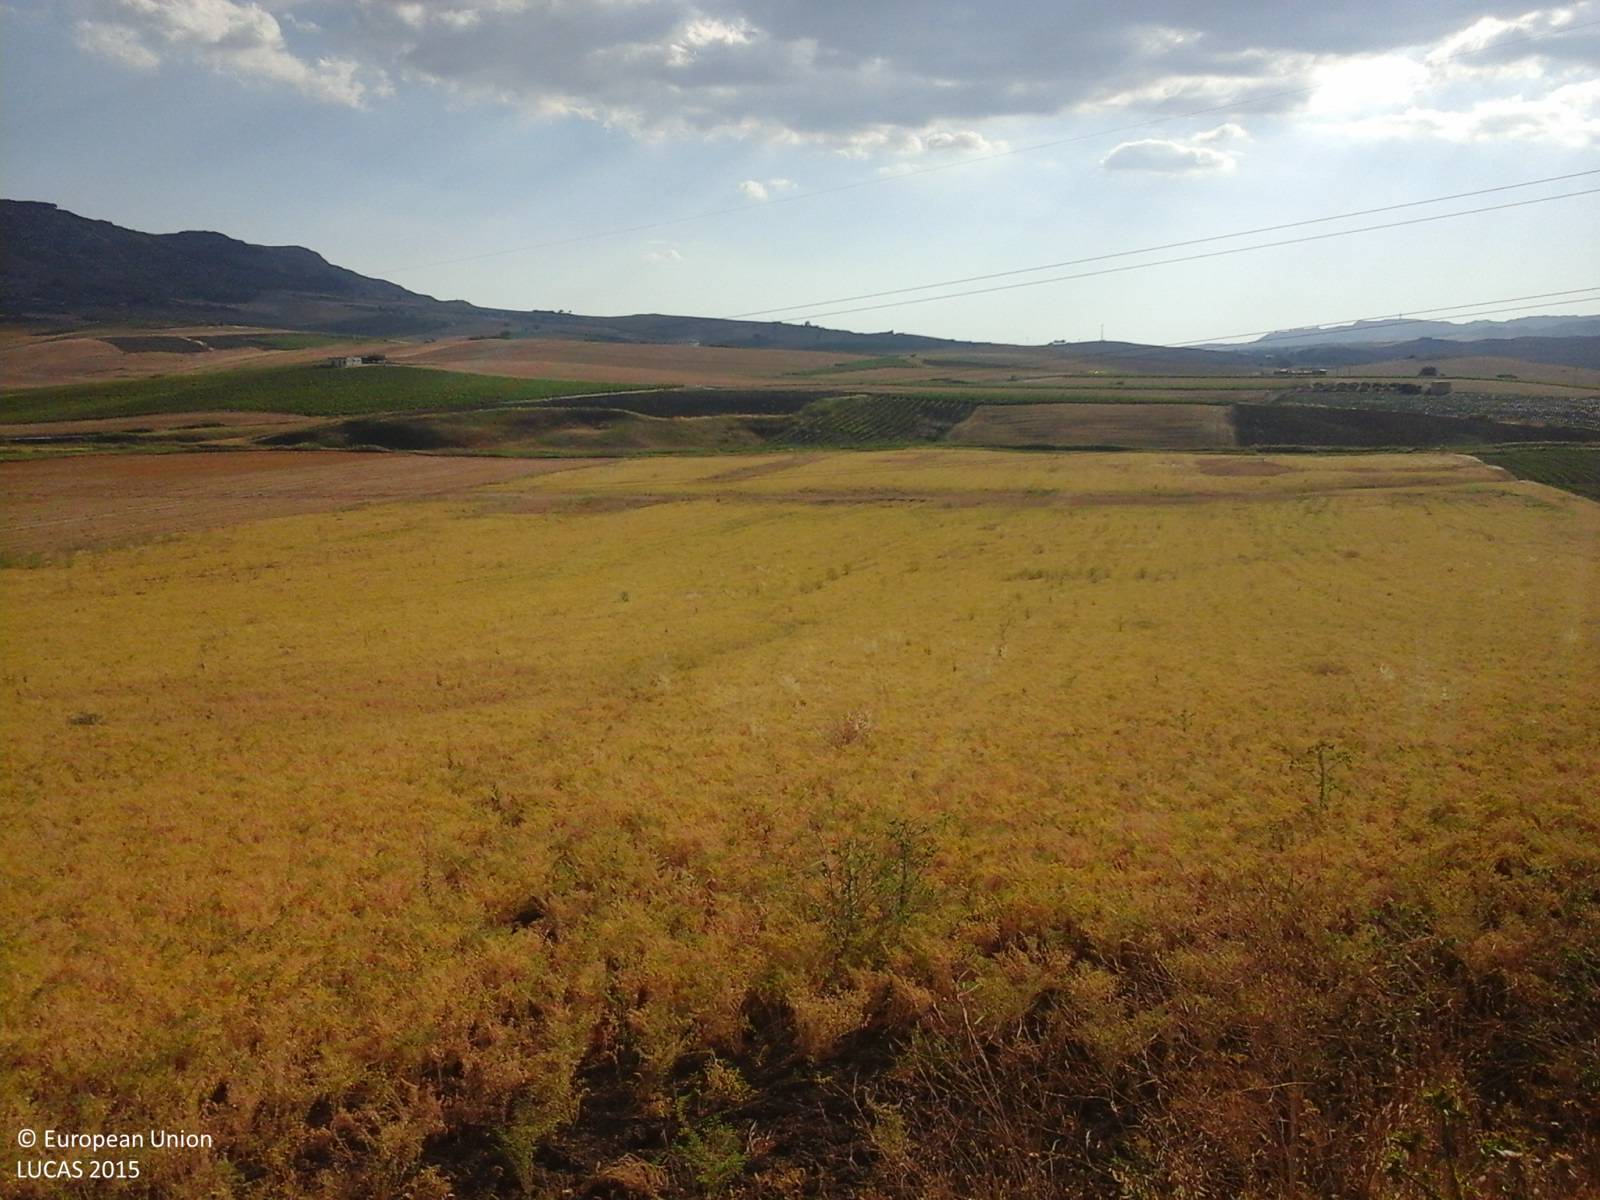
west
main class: Cropland
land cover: Dry pulses
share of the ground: > 75 %
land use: Agriculture (excluding fallow land and kitchen gardens)
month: July
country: IT
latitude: 37.8291
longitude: 12.9437
